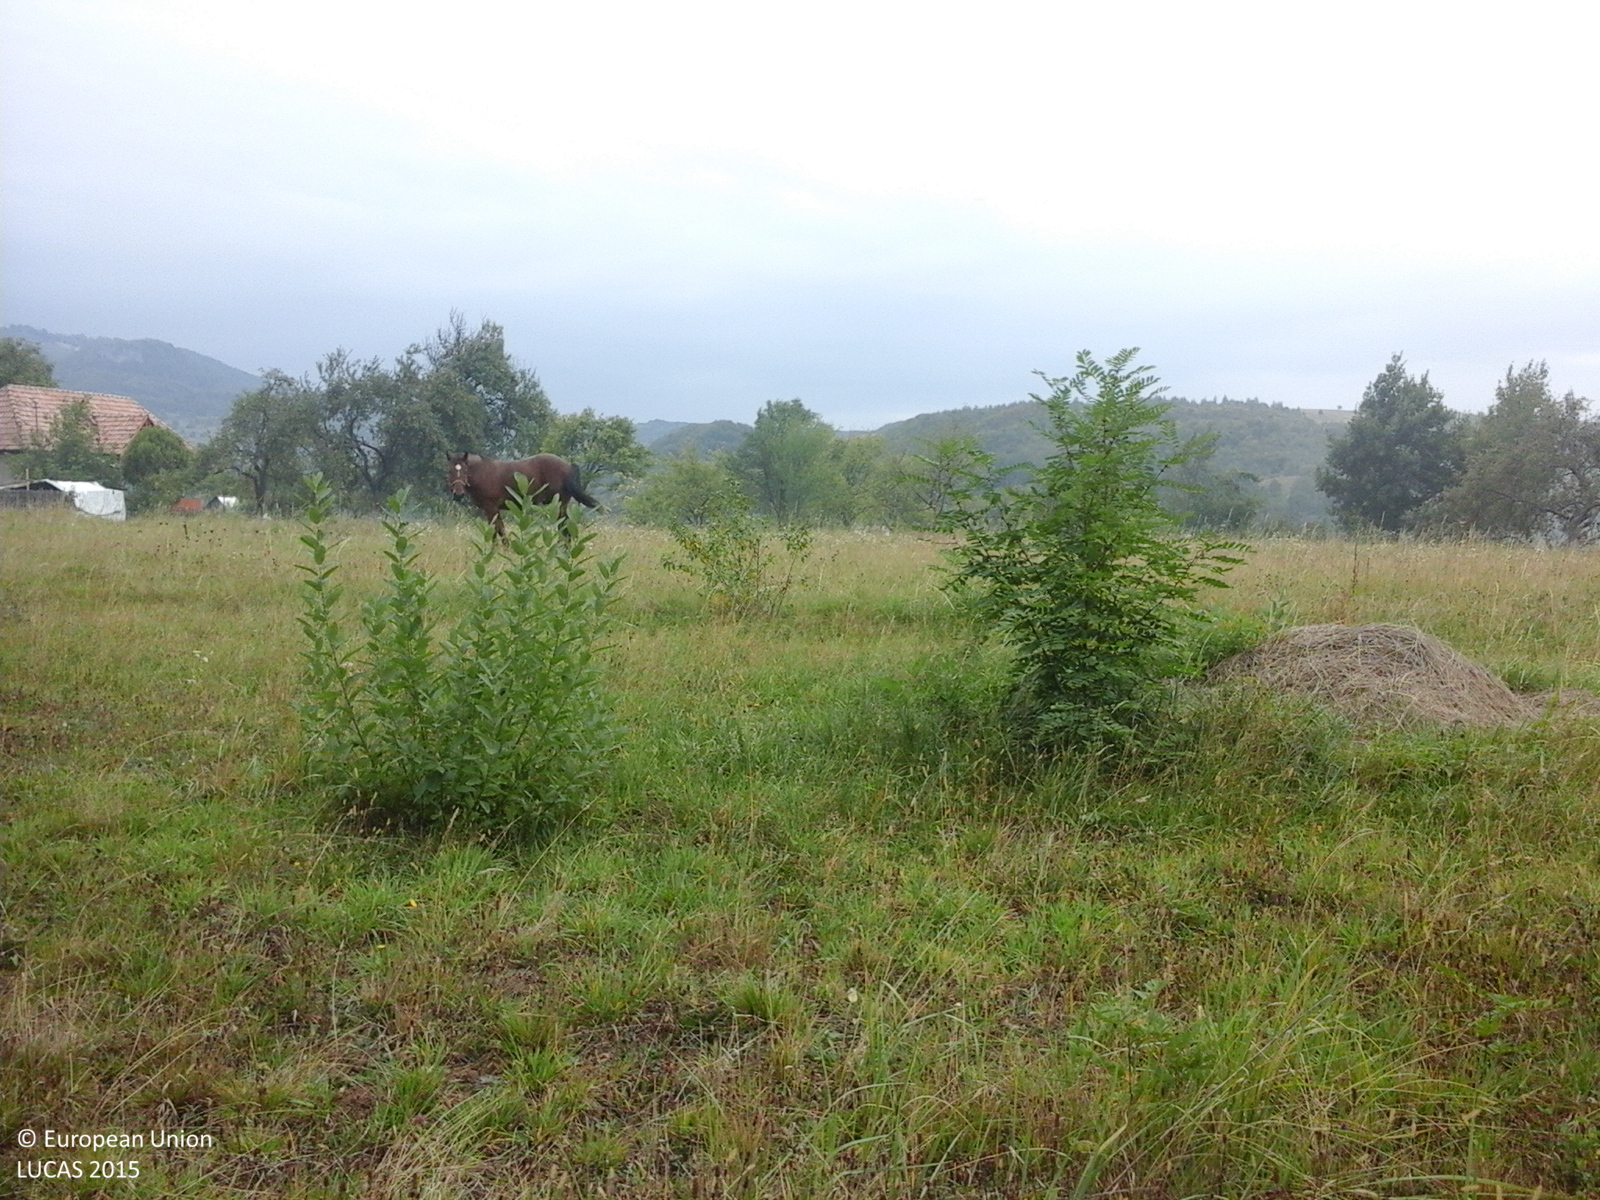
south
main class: Grassland
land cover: Spontaneously vegetated surfaces
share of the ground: > 75 %
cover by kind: herbaceous plants 100 %
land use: Agriculture (excluding fallow land and kitchen gardens)
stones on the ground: < 10 %
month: October
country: RO
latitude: 46.7740
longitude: 24.9626
